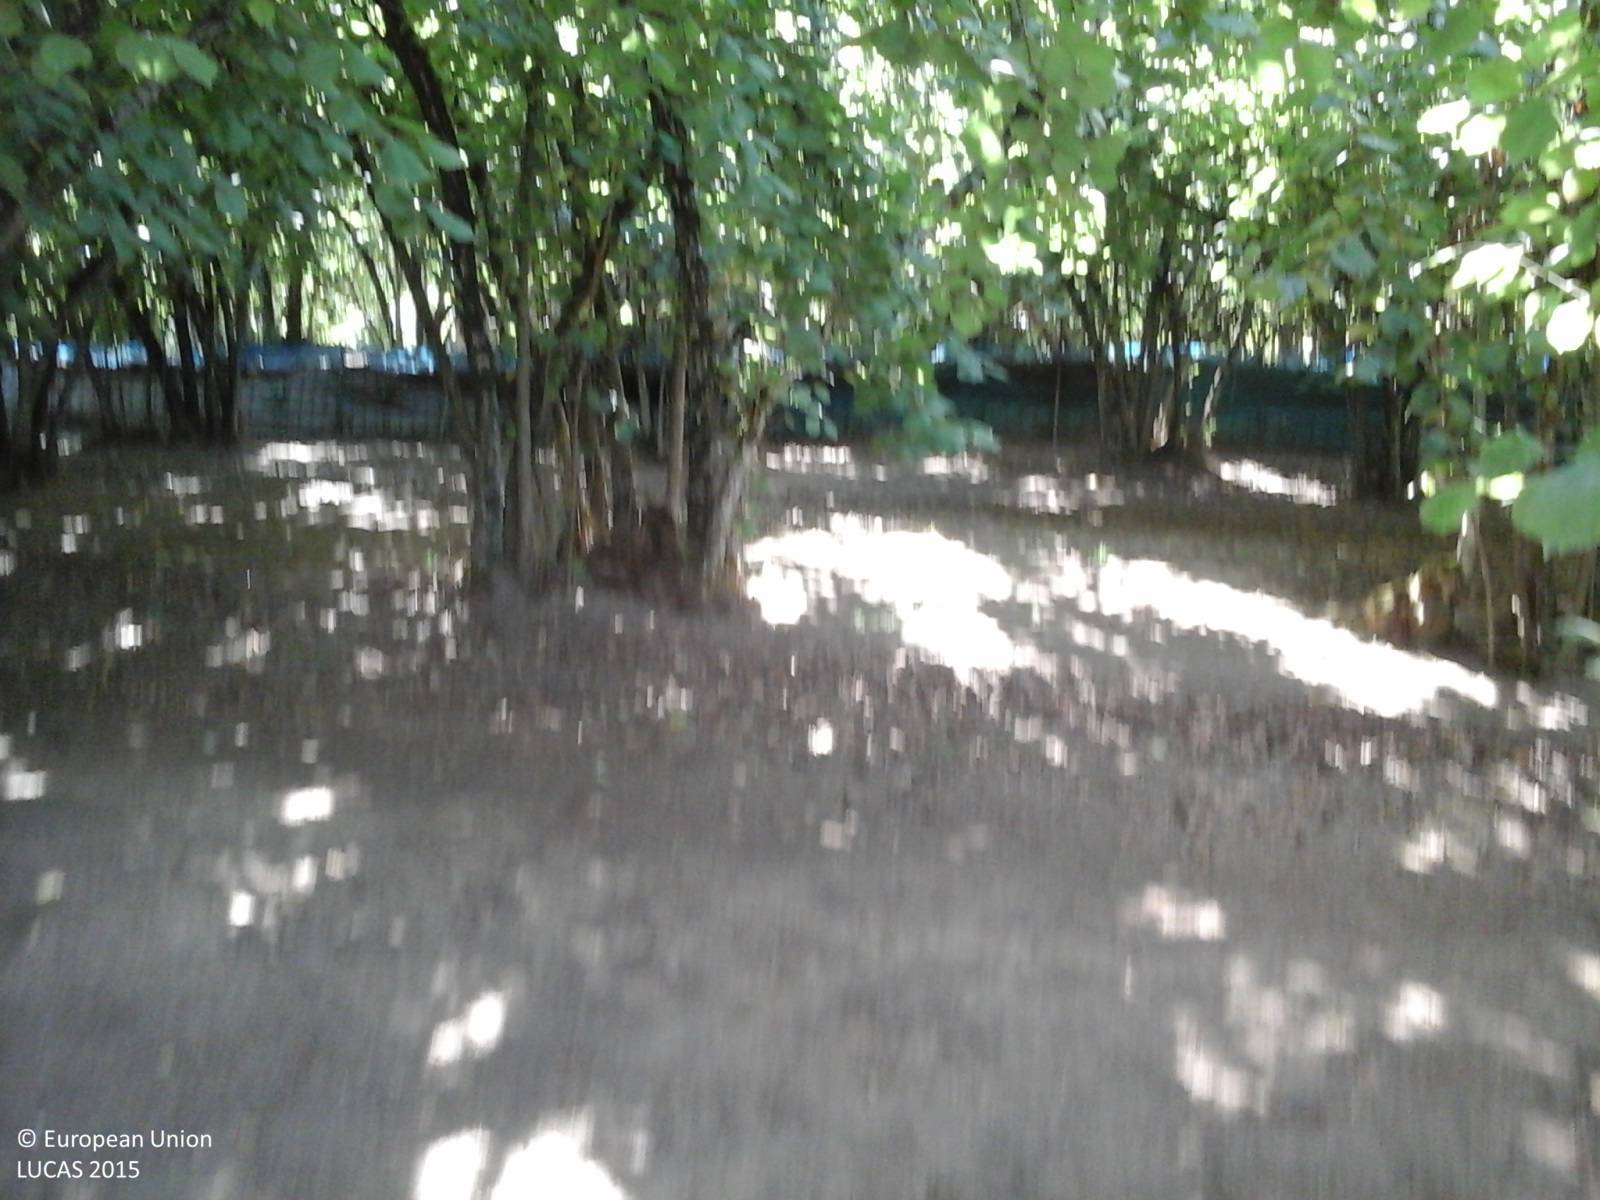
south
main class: Cropland
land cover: Nuts trees
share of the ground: > 75 %
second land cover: Other bare soil
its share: > 75 %
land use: Agriculture (excluding fallow land and kitchen gardens)
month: September
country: IT
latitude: 42.3211
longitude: 12.2854
